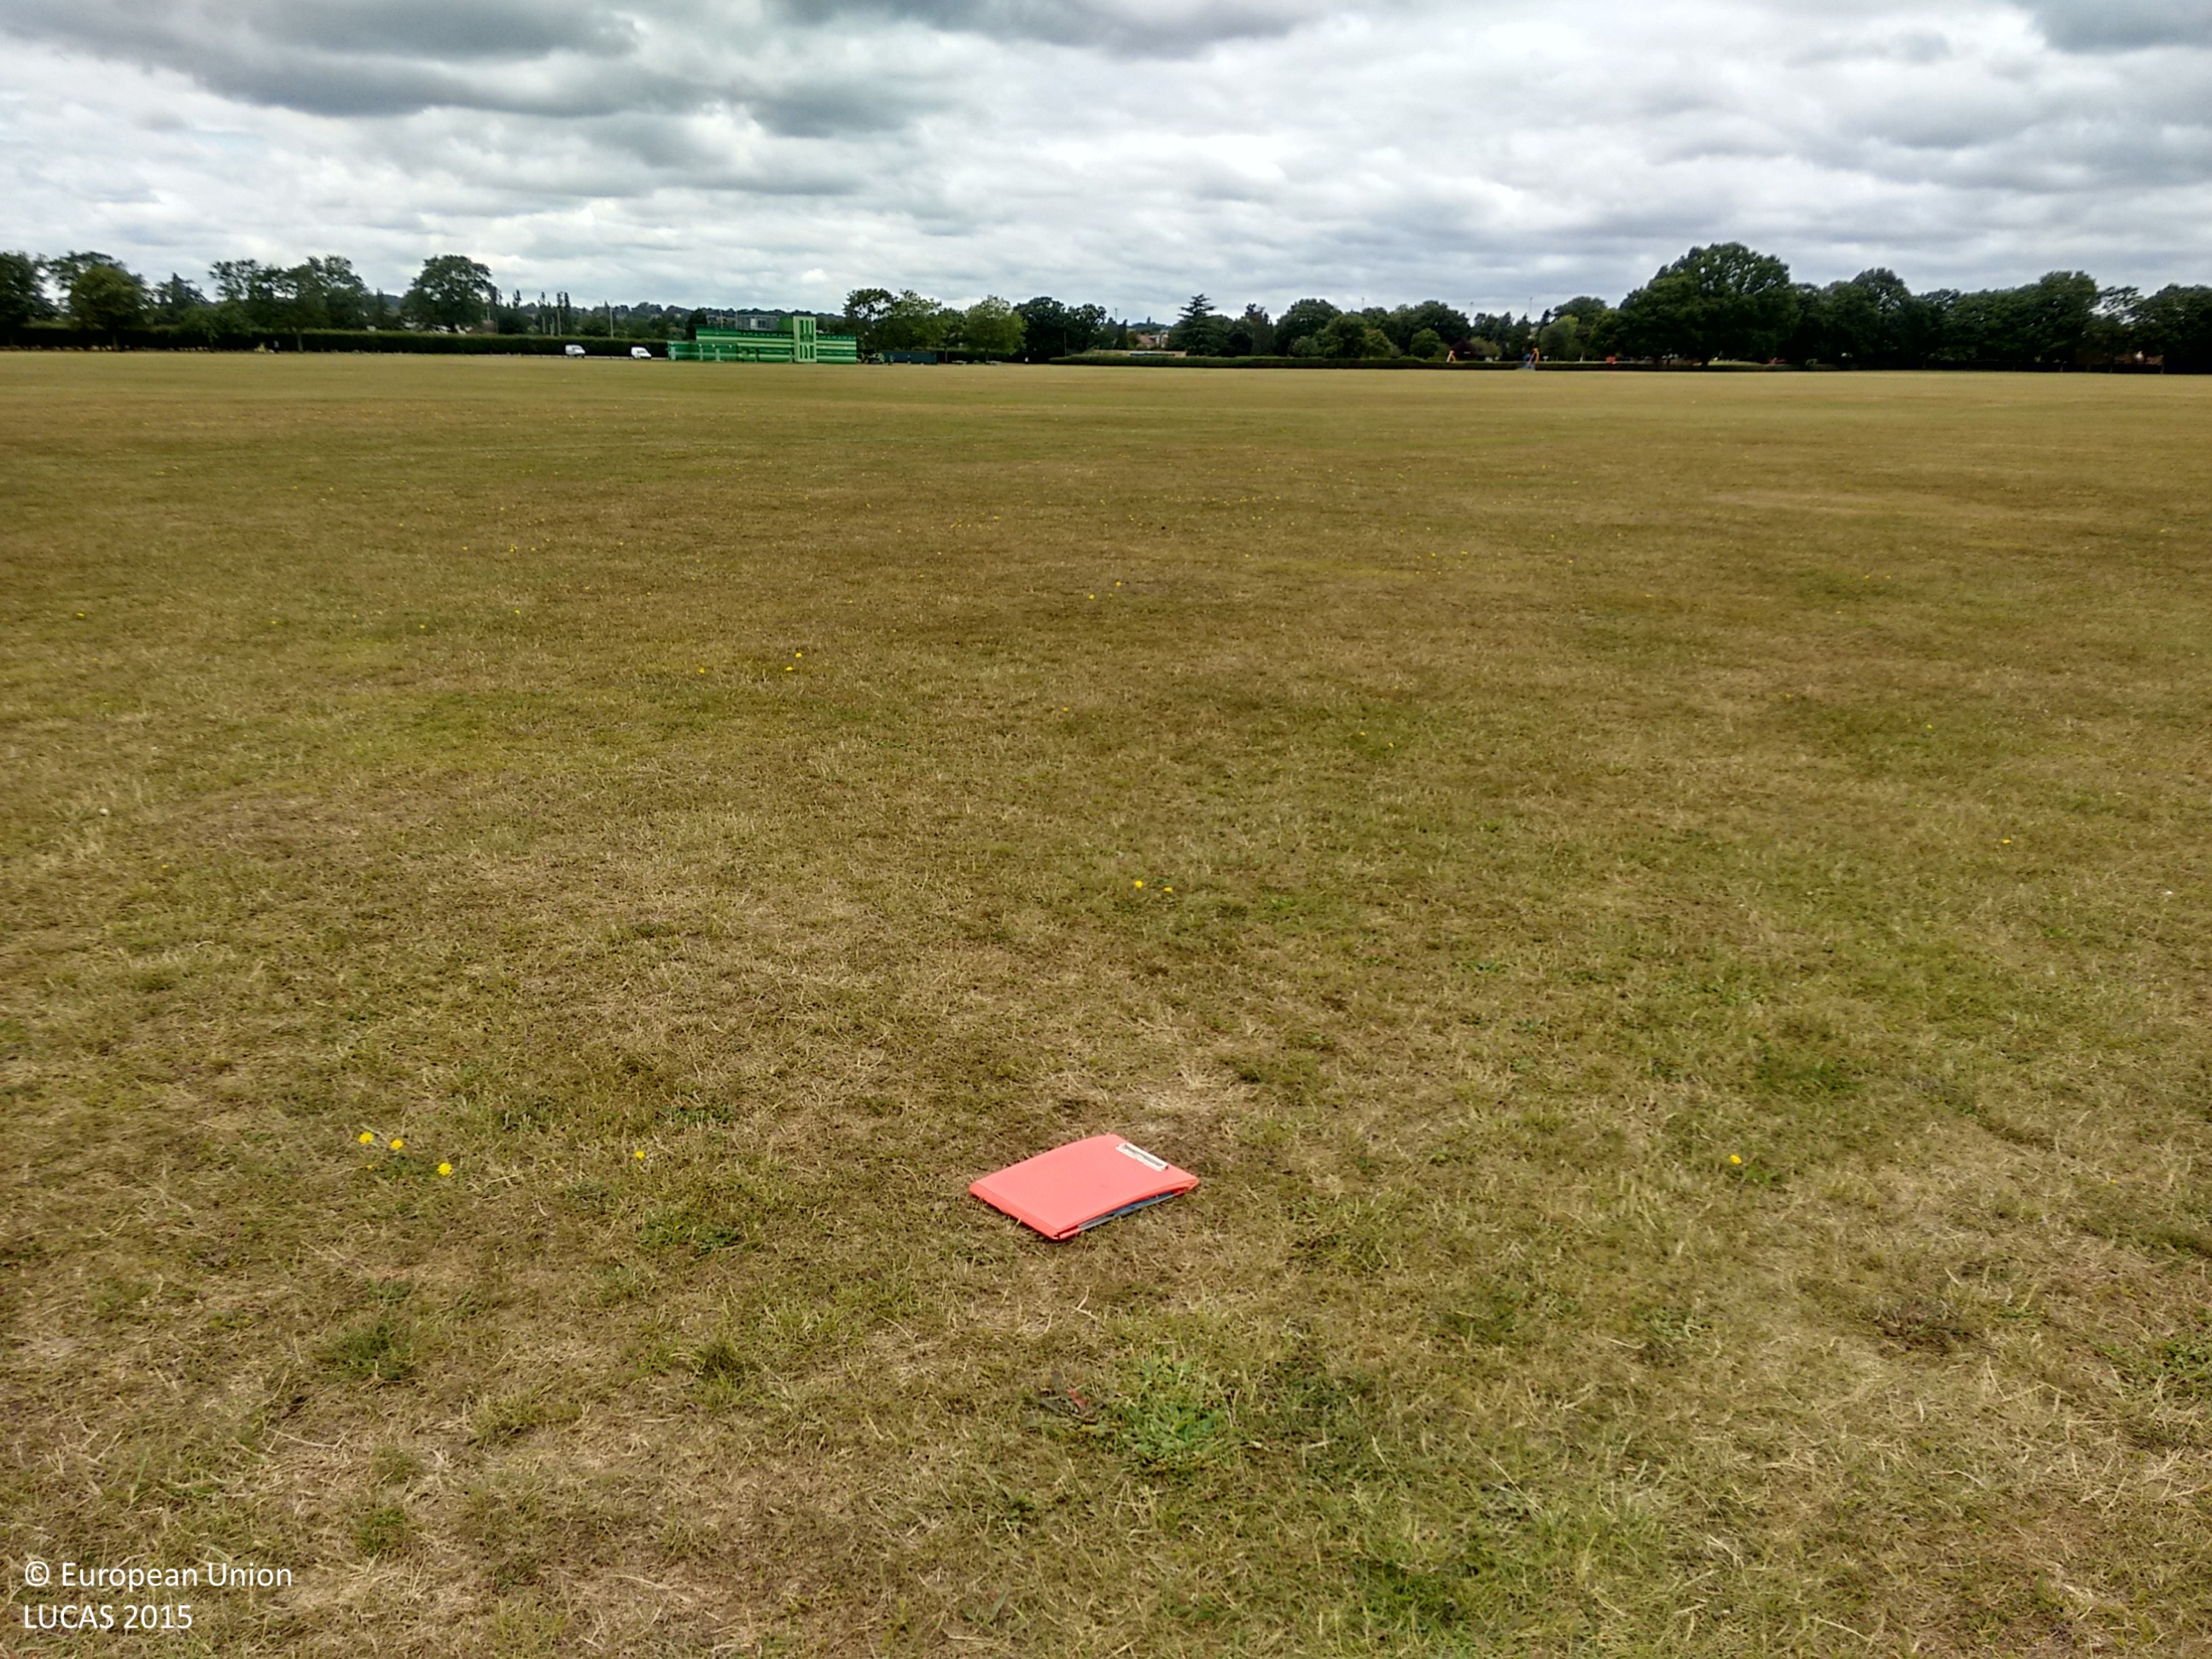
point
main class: Grassland
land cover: Grassland without tree/shrub cover
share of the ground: > 75 %
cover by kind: herbaceous plants 100 %
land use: Sport
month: July
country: GB
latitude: 51.6010
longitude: 0.1075
